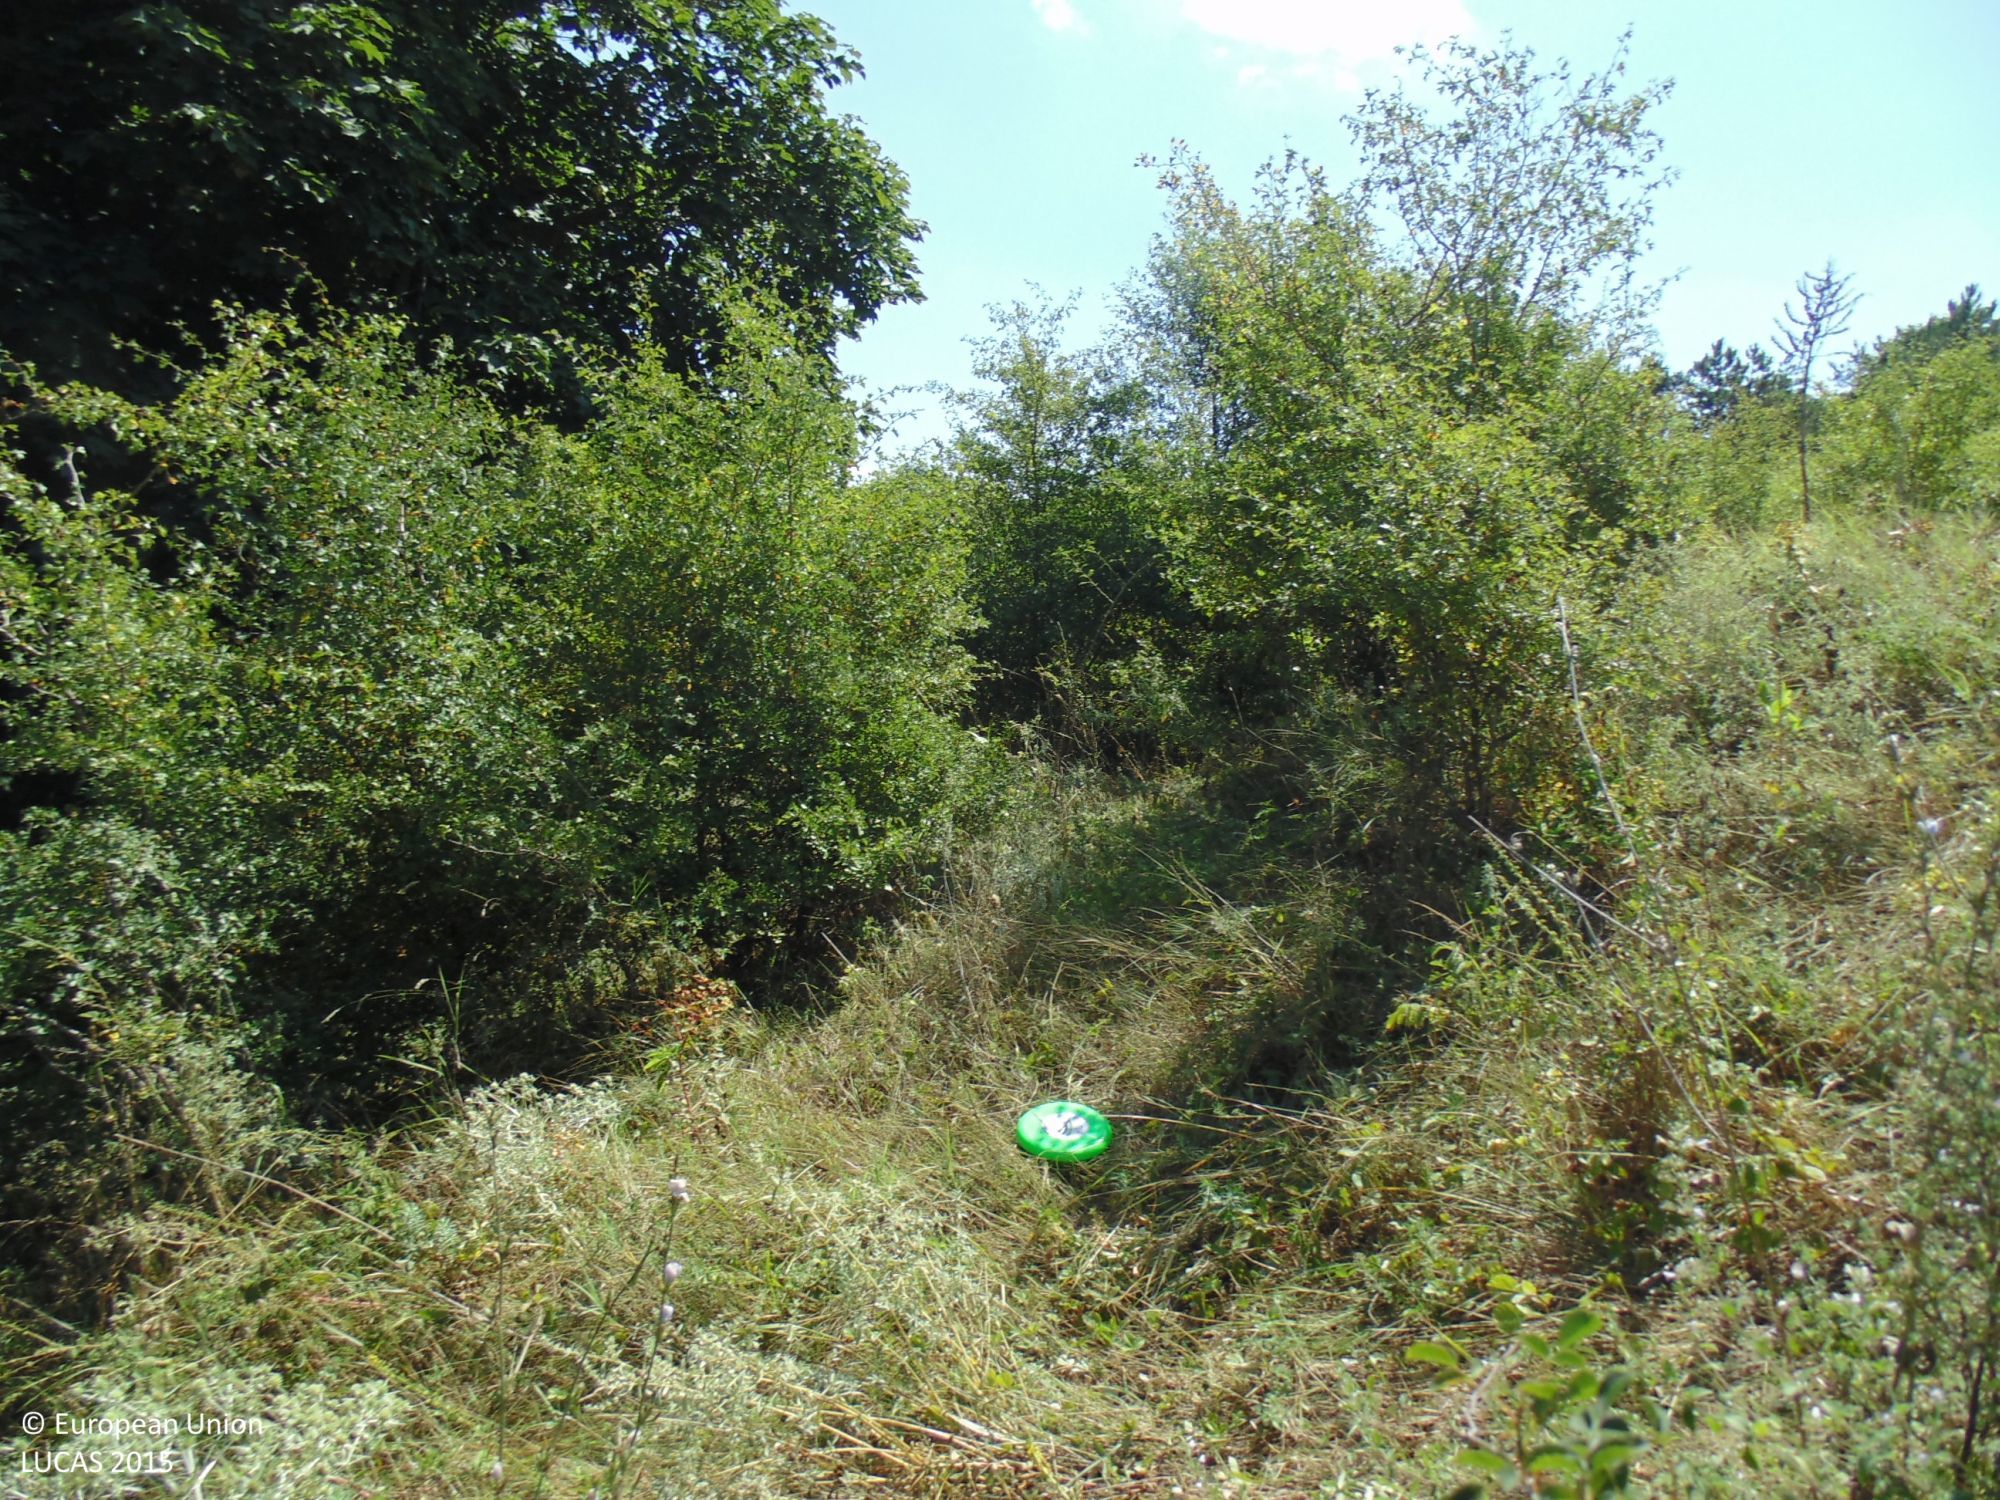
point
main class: Woodland
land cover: Broadleaved woodland
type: mesophytic deciduous forest
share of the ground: 25 - 50 %
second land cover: Grassland without tree/shrub cover
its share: > 75 %
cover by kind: herbaceous plants 70 %, broadleaved forest trees 25 %, shrubs 5 %
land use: Forestry
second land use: Agriculture (excluding fallow land and kitchen gardens)
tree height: < 5 m
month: August
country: BG
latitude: 43.6397
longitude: 28.1383
